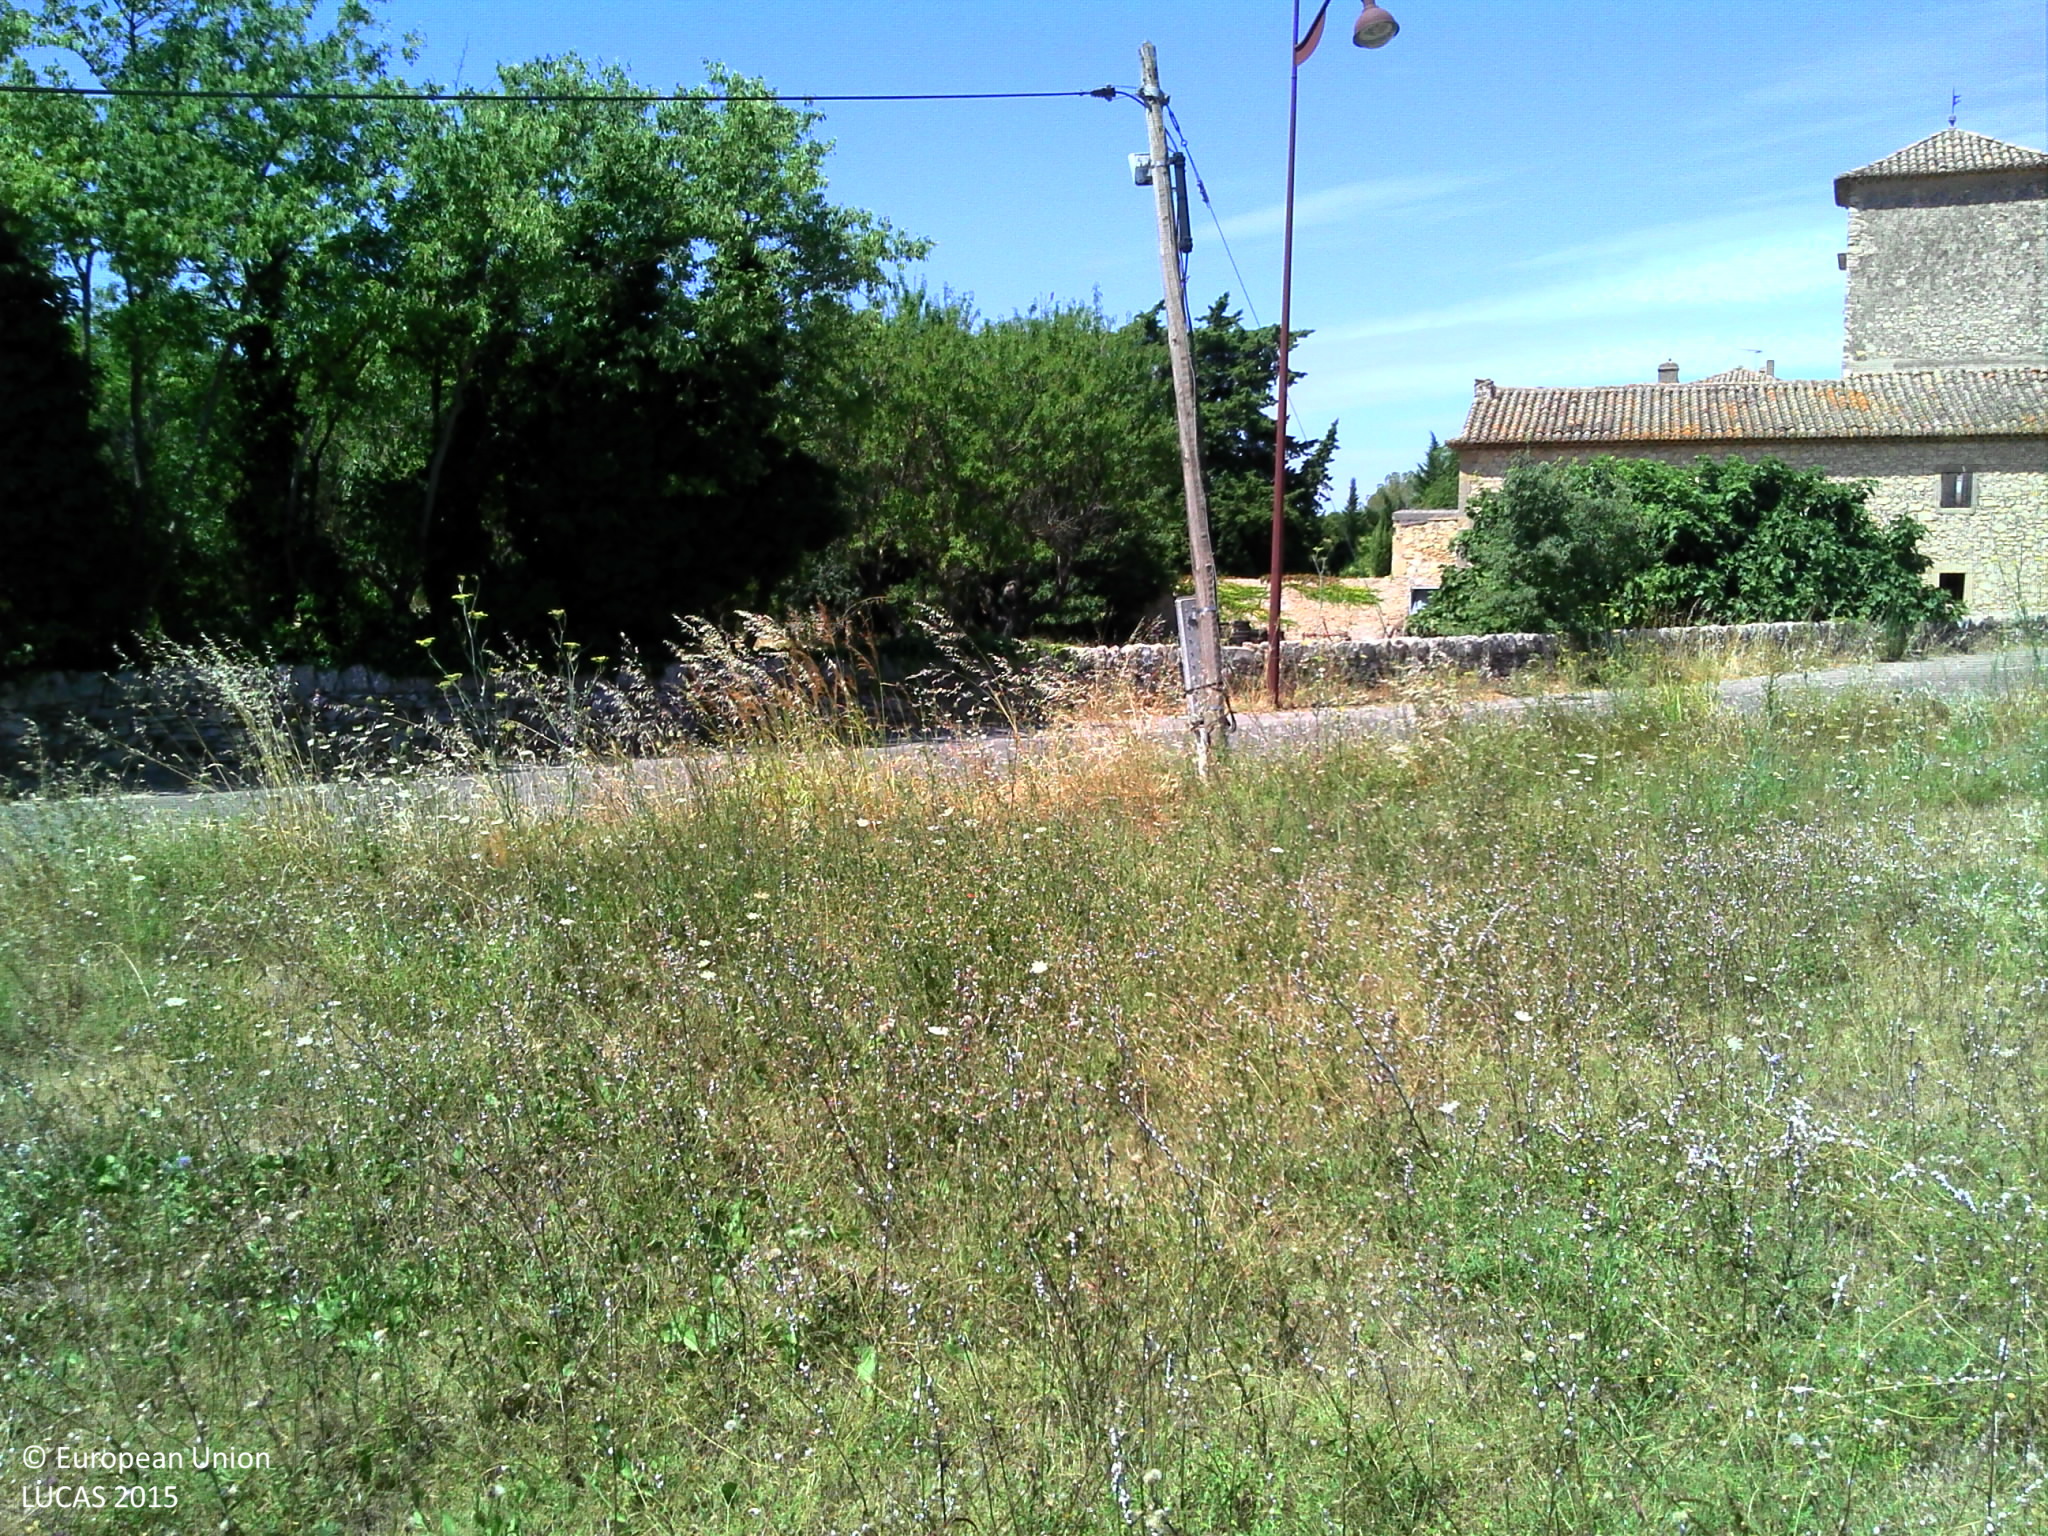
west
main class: Grassland
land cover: Grassland without tree/shrub cover
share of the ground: > 75 %
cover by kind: herbaceous plants 95 %, unconsolidated bare surface 5 %
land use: Agriculture (excluding fallow land and kitchen gardens)
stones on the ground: < 10 %
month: July
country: FR
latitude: 43.7518
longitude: 5.2029
